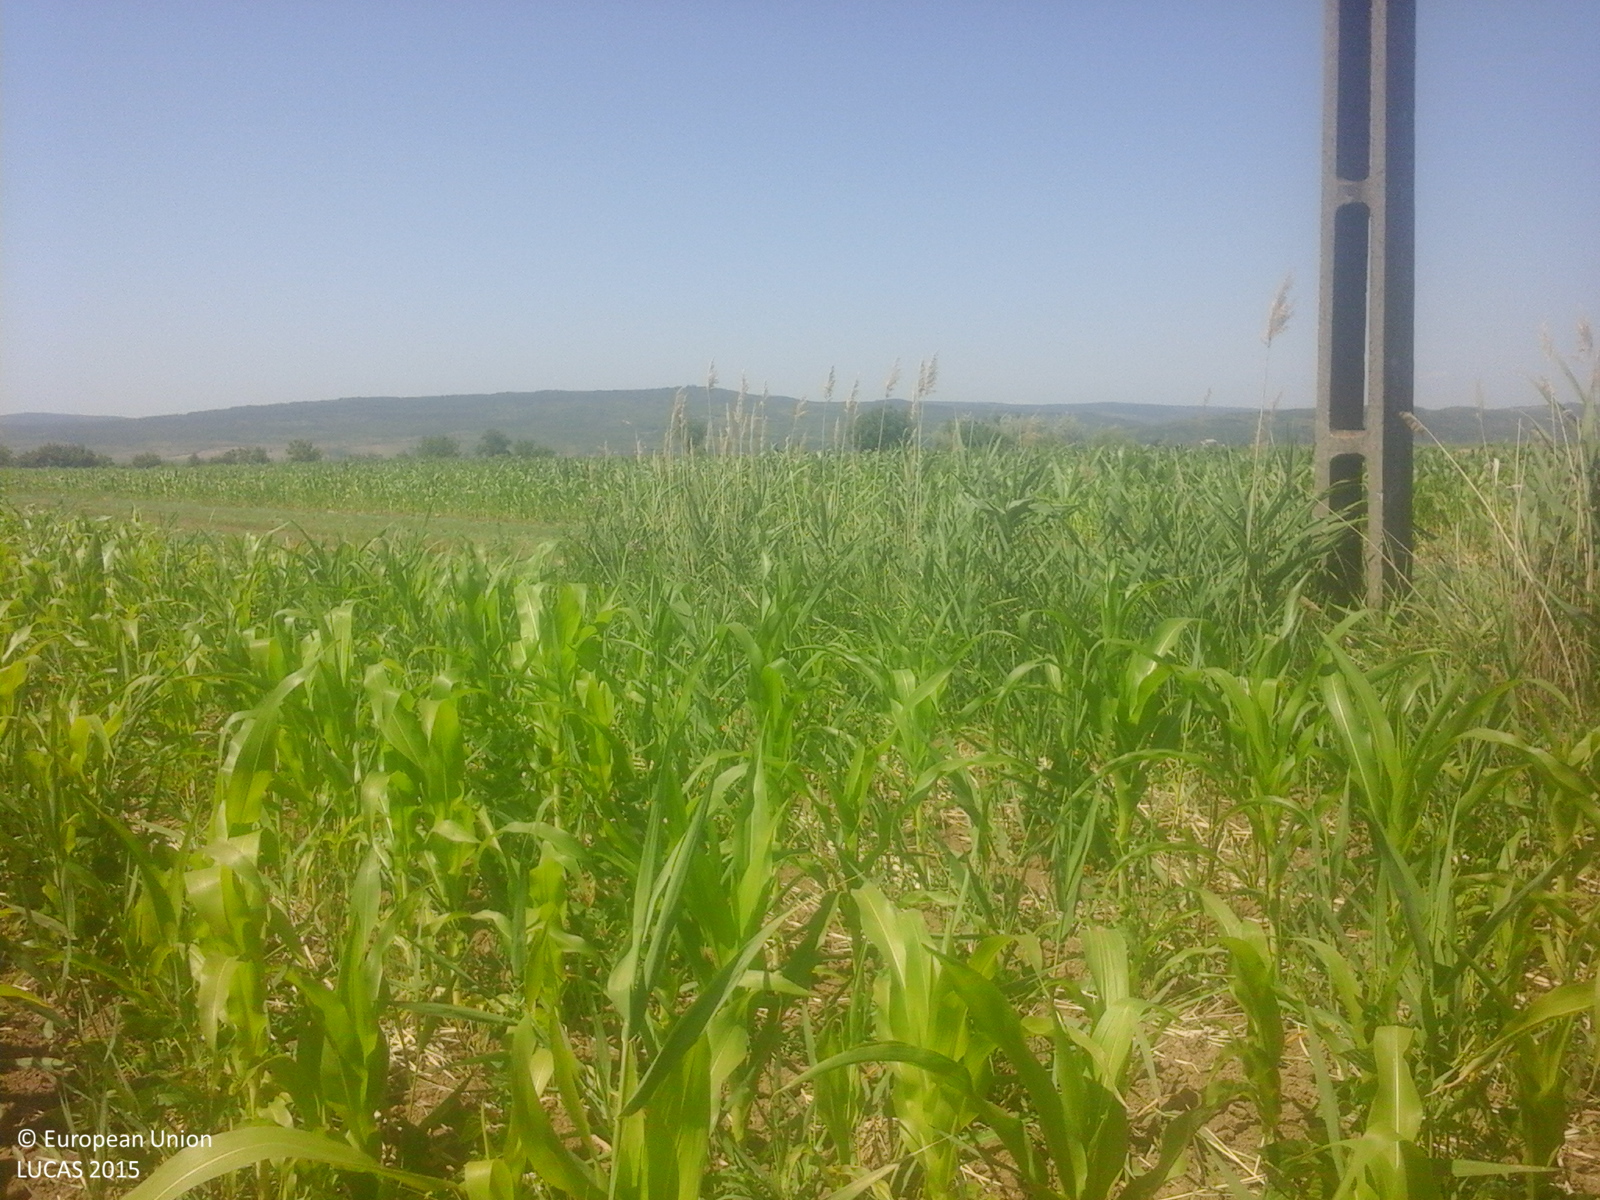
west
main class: Cropland
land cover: Maize
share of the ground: > 75 %
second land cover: Dry pulses
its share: 25 - 50 %
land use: Agriculture (excluding fallow land and kitchen gardens)
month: June
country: RO
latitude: 47.1011
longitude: 27.8480
